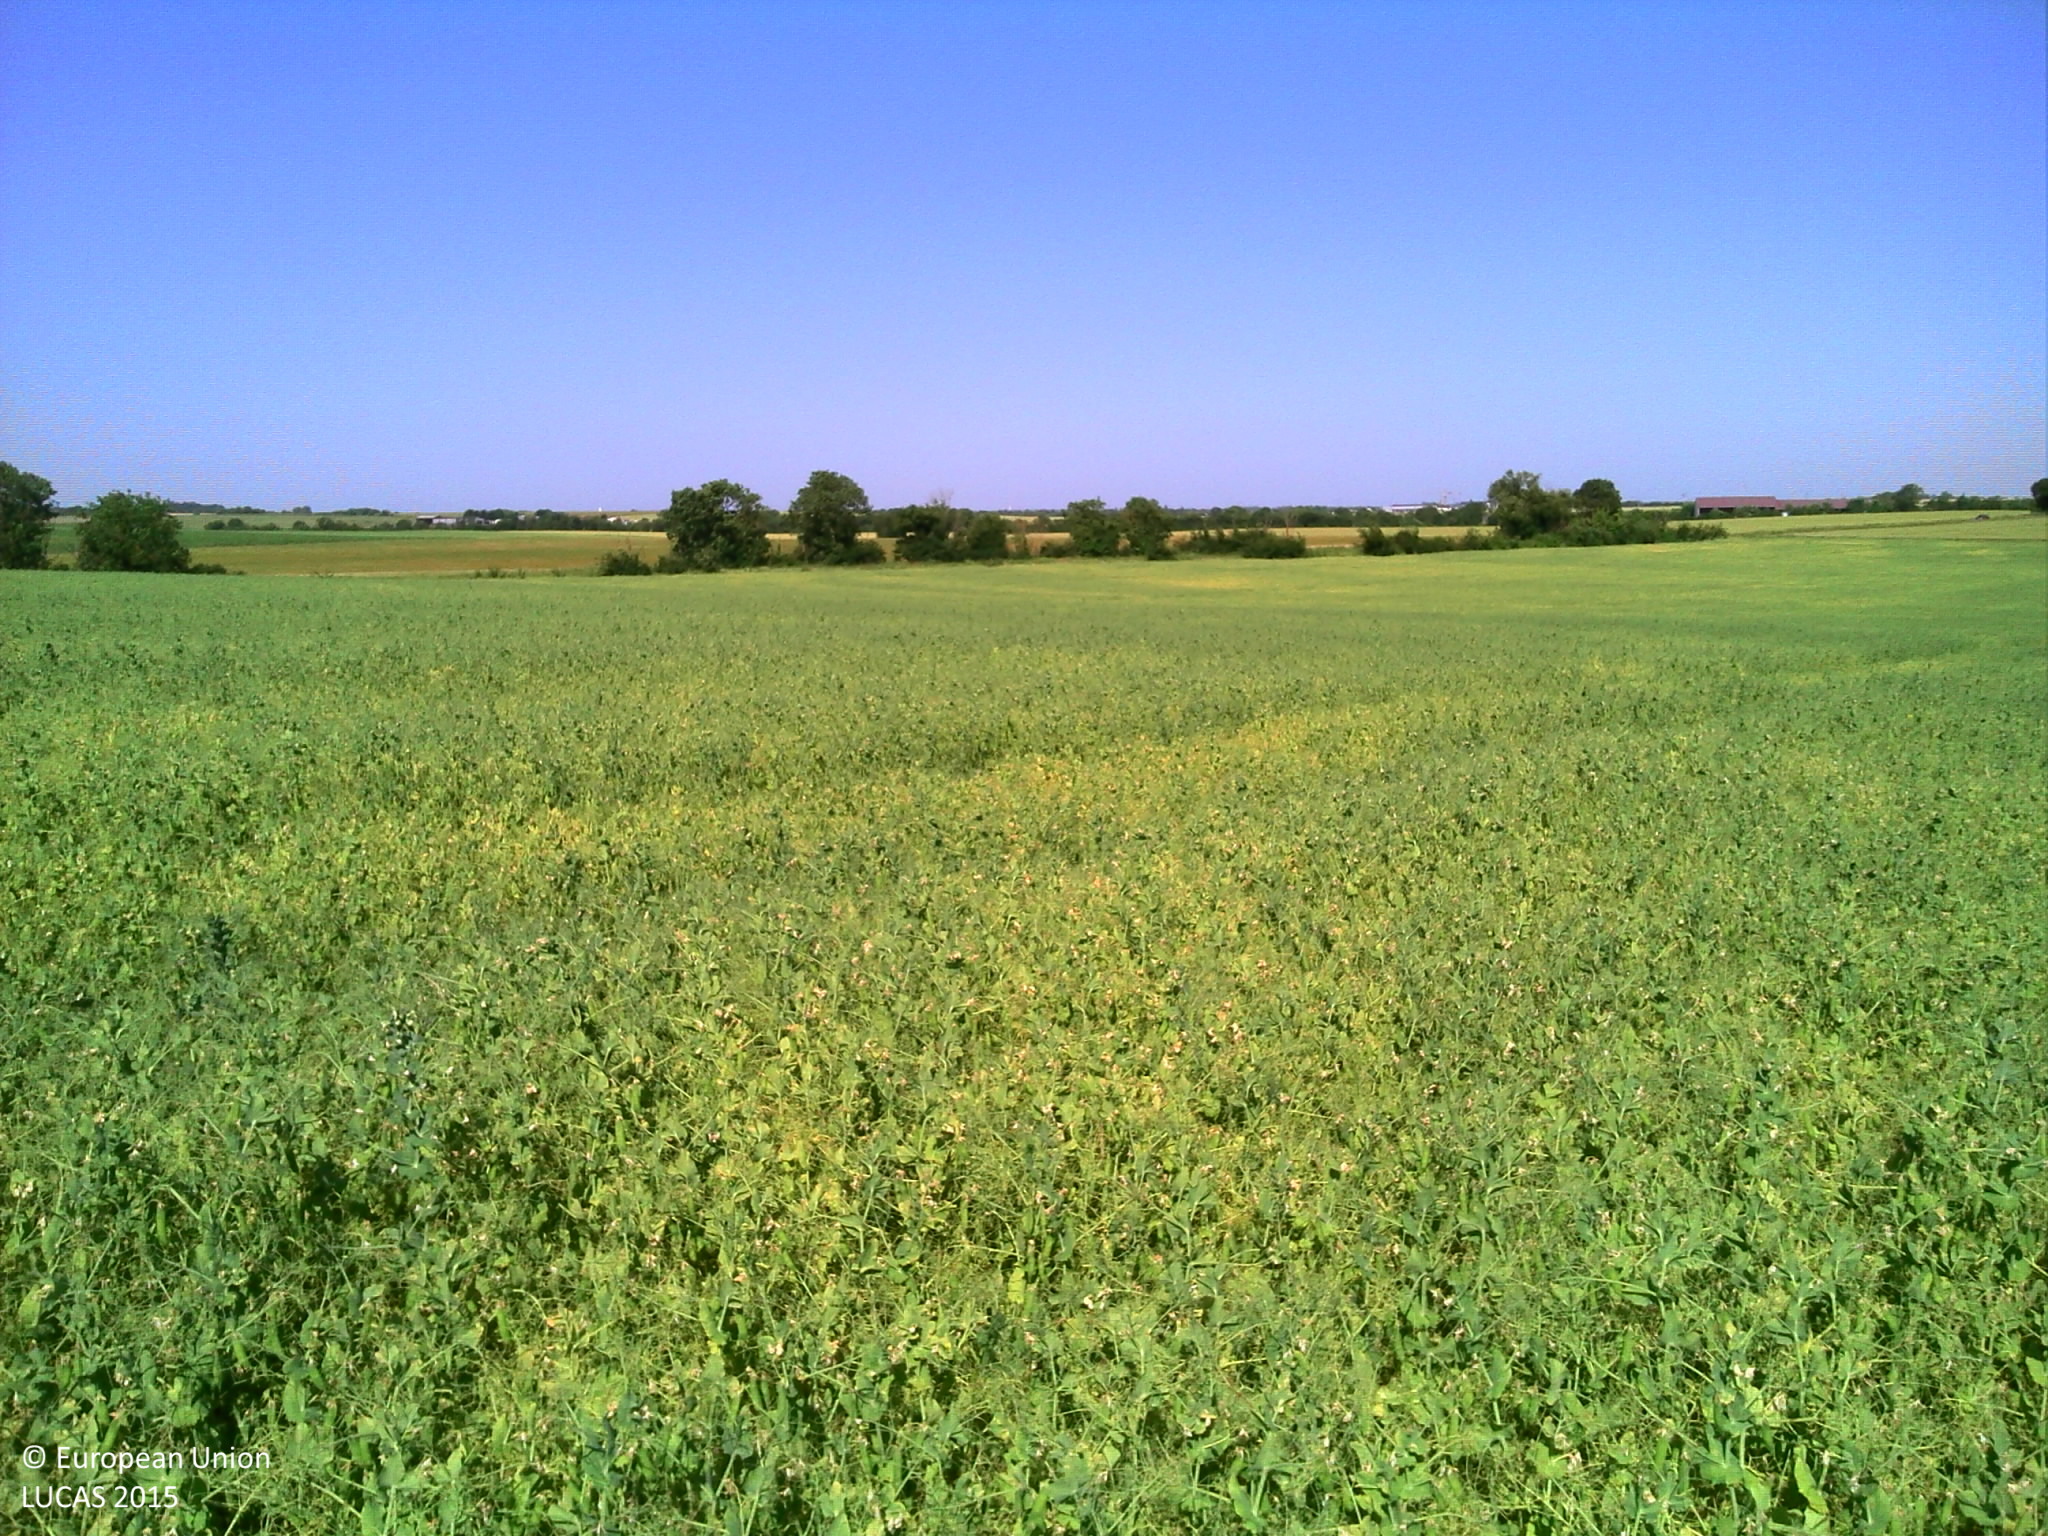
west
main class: Cropland
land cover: Dry pulses
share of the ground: > 75 %
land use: Agriculture (excluding fallow land and kitchen gardens)
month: June
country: FR
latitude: 46.2019
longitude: -0.9811
